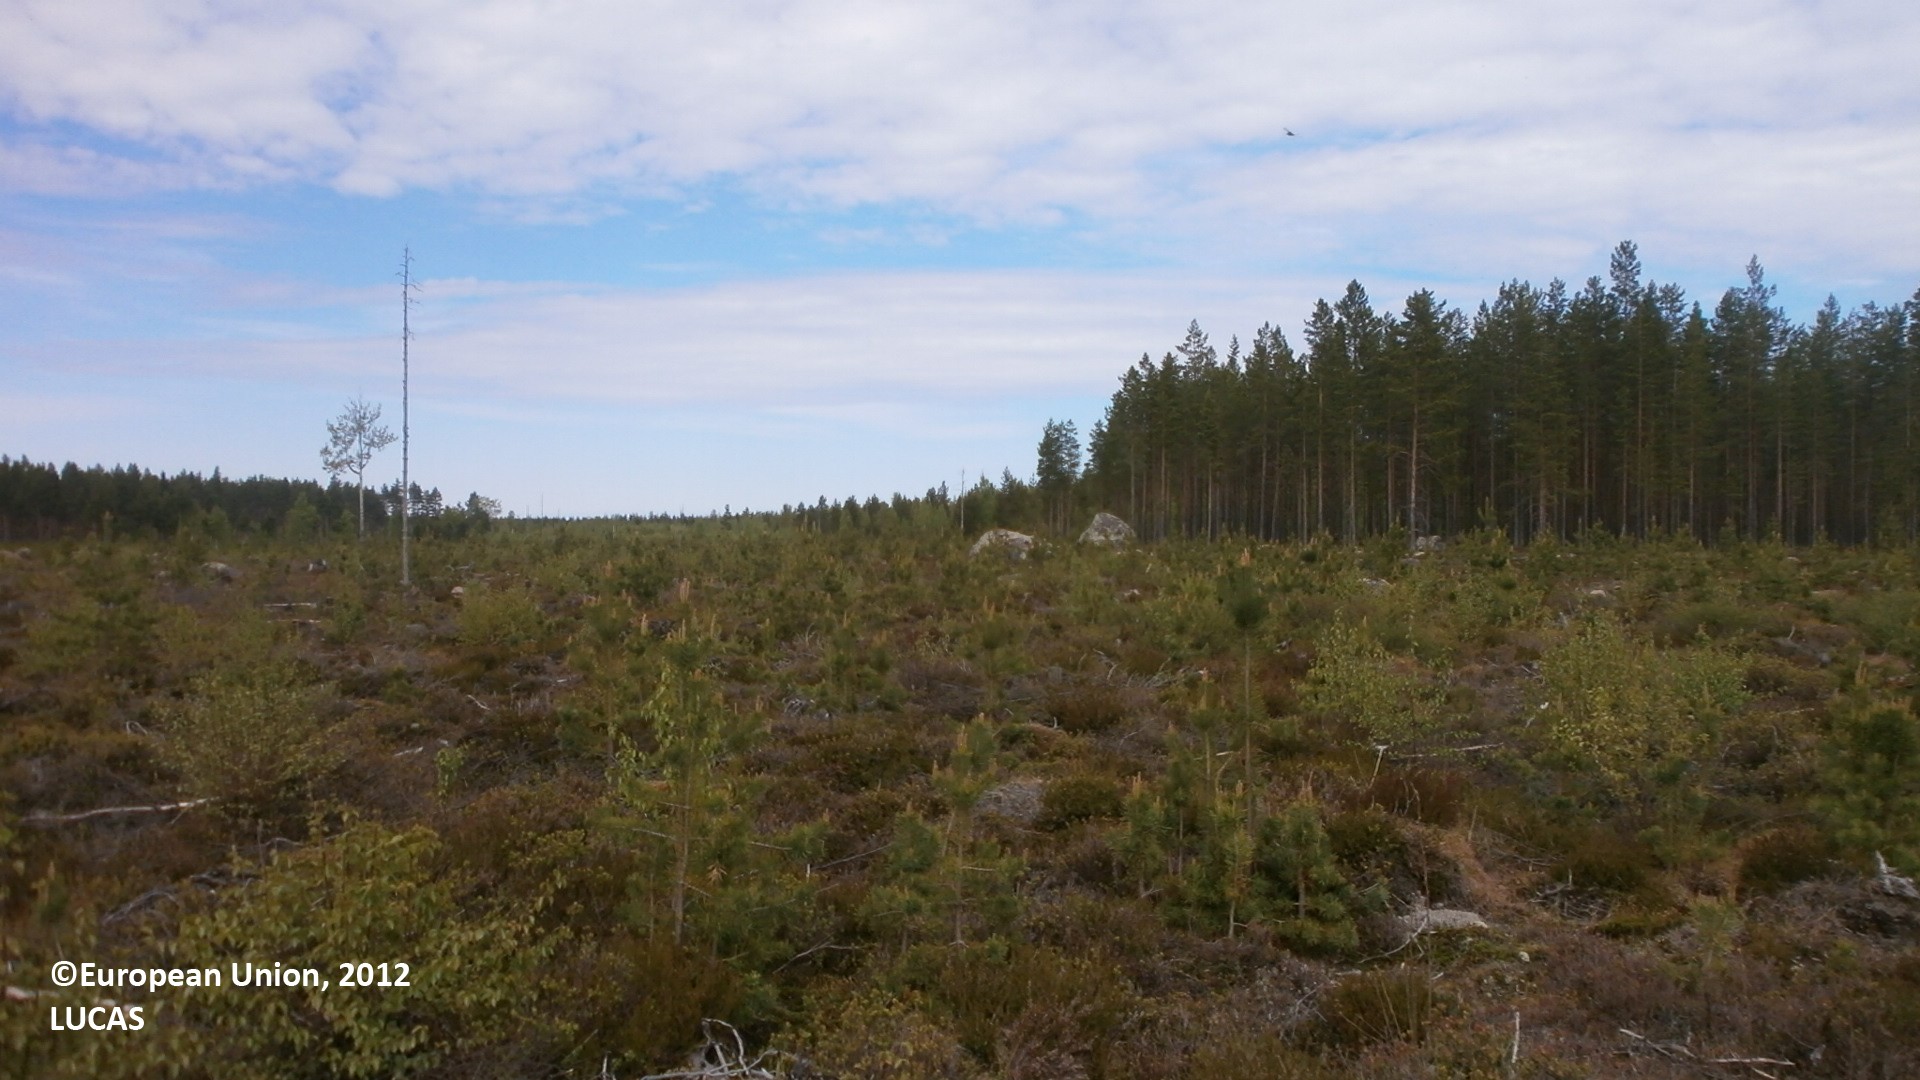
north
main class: Woodland
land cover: Other mixed woodland
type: hemiboreal forest and nemoral coniferous forest and mixed broadleaved-coniferous forest
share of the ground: 10 - 25 %
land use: Forestry
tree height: < 5 m
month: June
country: FI
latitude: 64.4701
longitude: 25.0323
